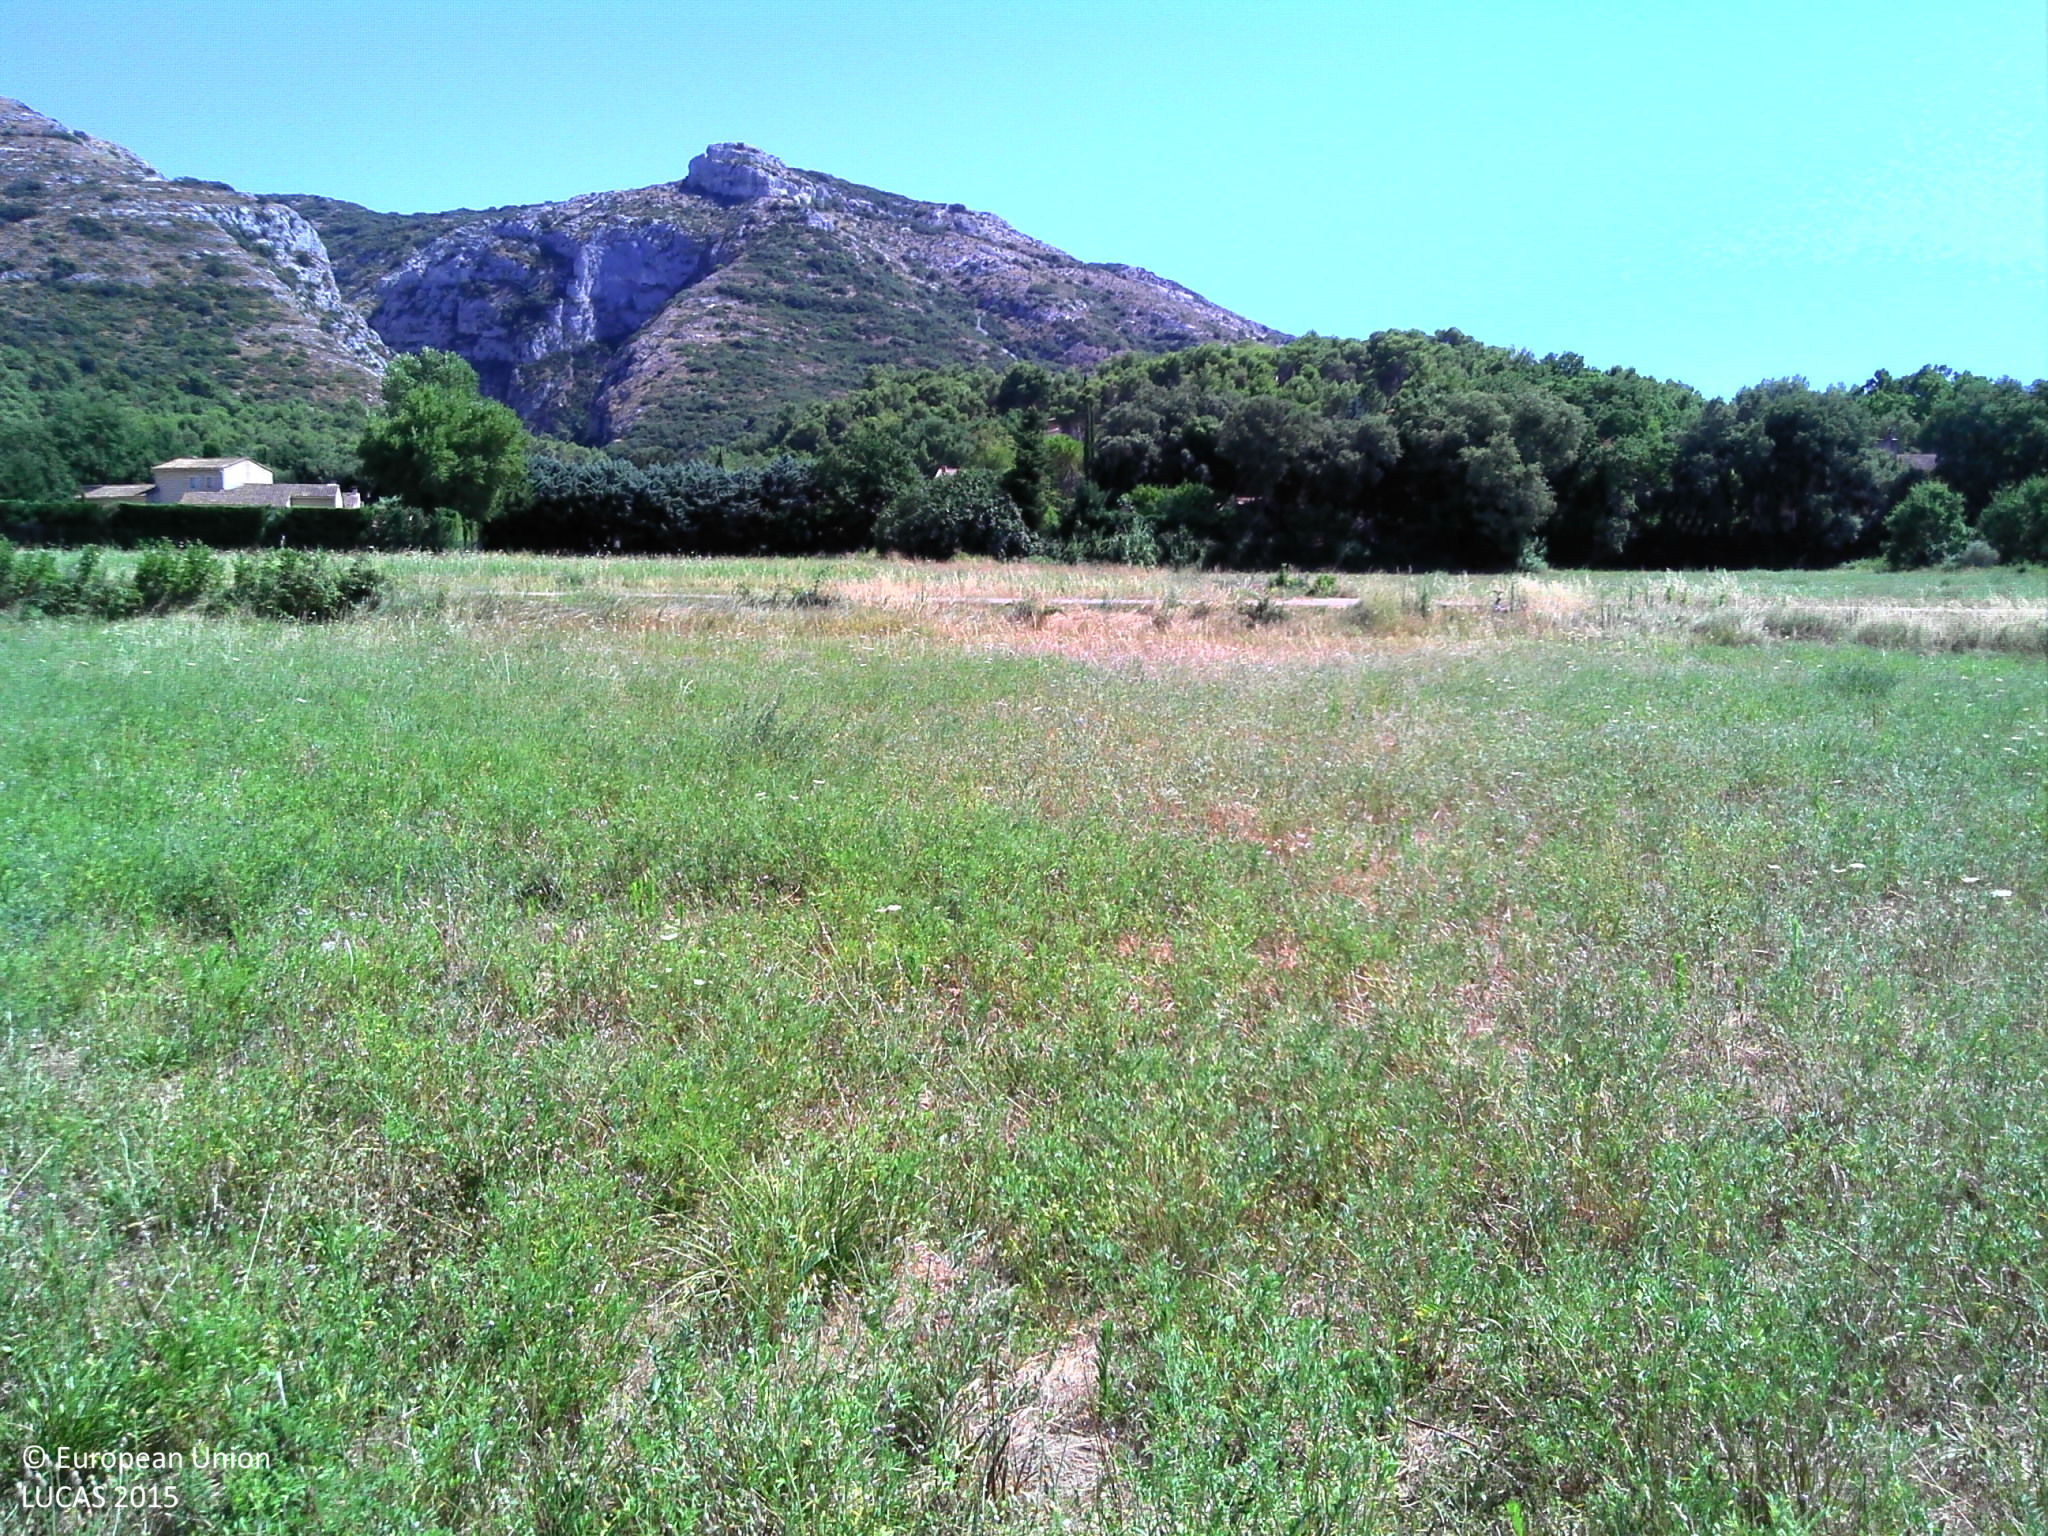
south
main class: Grassland
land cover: Grassland without tree/shrub cover
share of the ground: > 75 %
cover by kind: herbaceous plants 95 %, unconsolidated bare surface 5 %
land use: Agriculture (excluding fallow land and kitchen gardens)
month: July
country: FR
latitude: 43.8371
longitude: 5.0963
